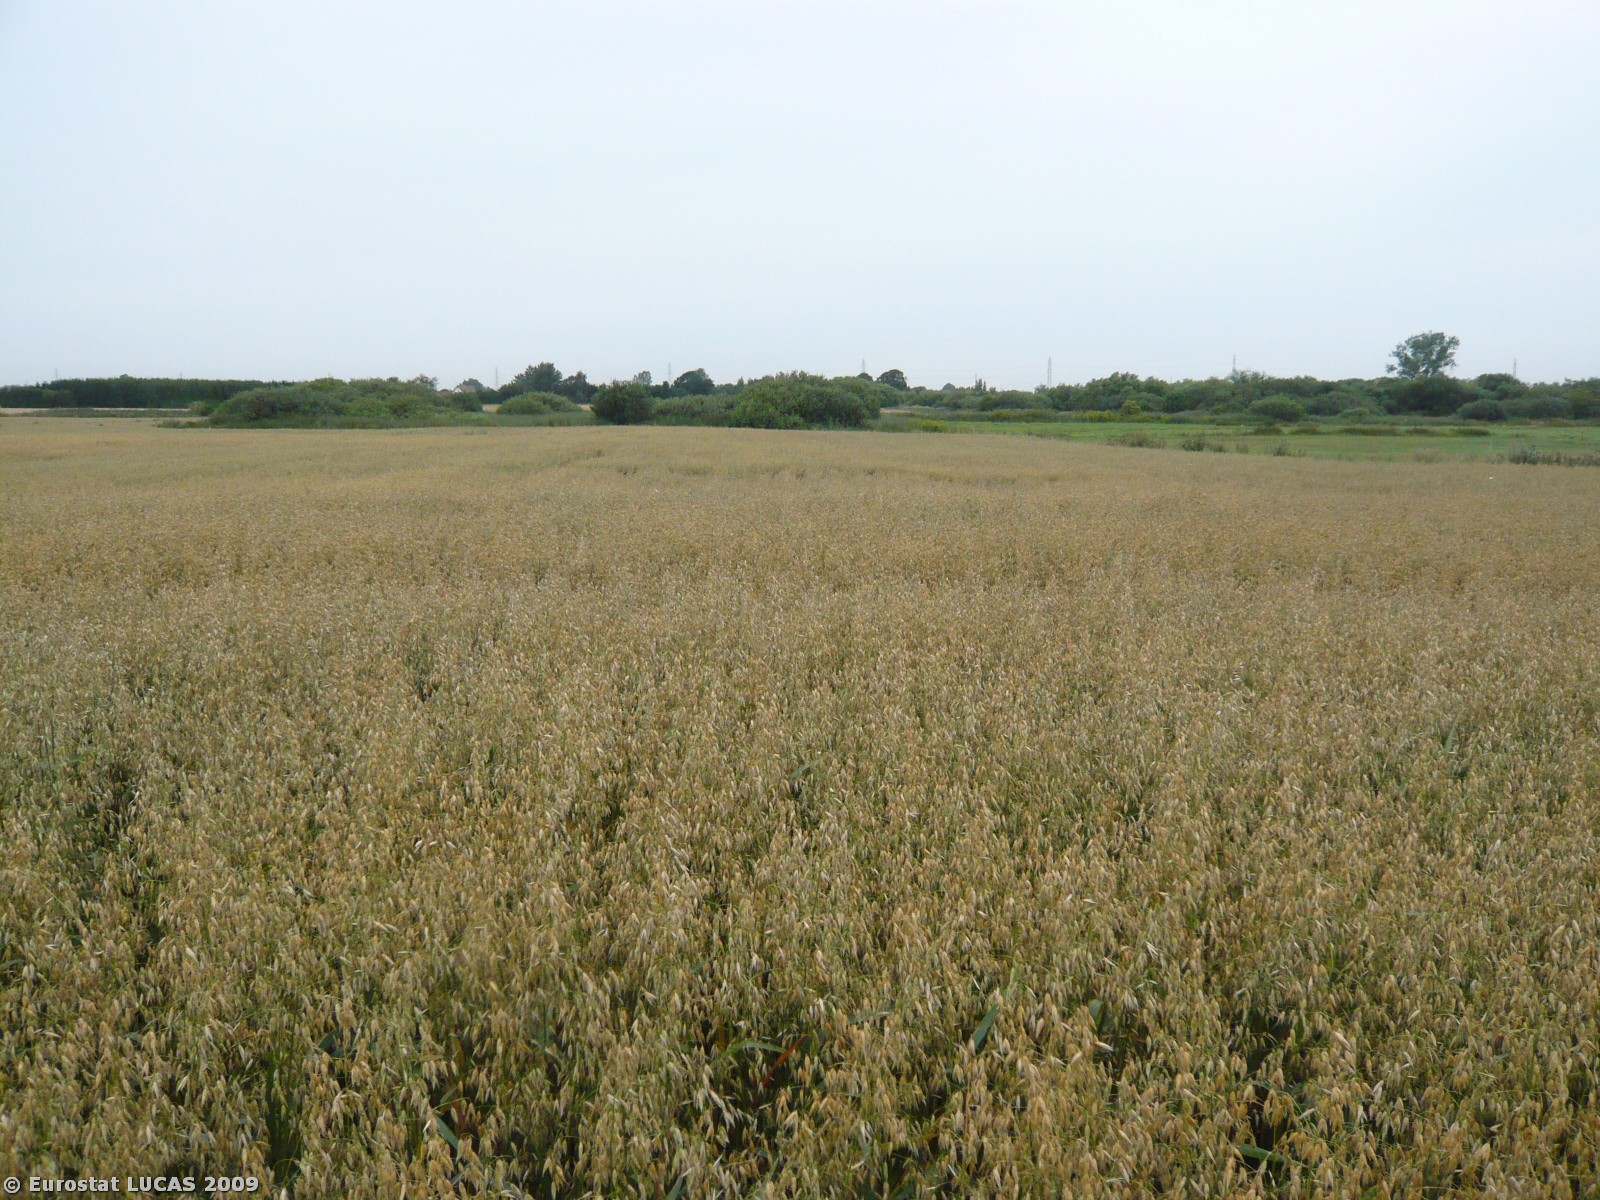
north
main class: Cropland
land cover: Oats
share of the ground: > 75 %
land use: Agriculture (excluding fallow land and kitchen gardens)
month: July
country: DK
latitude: 55.7377
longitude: 12.1801
